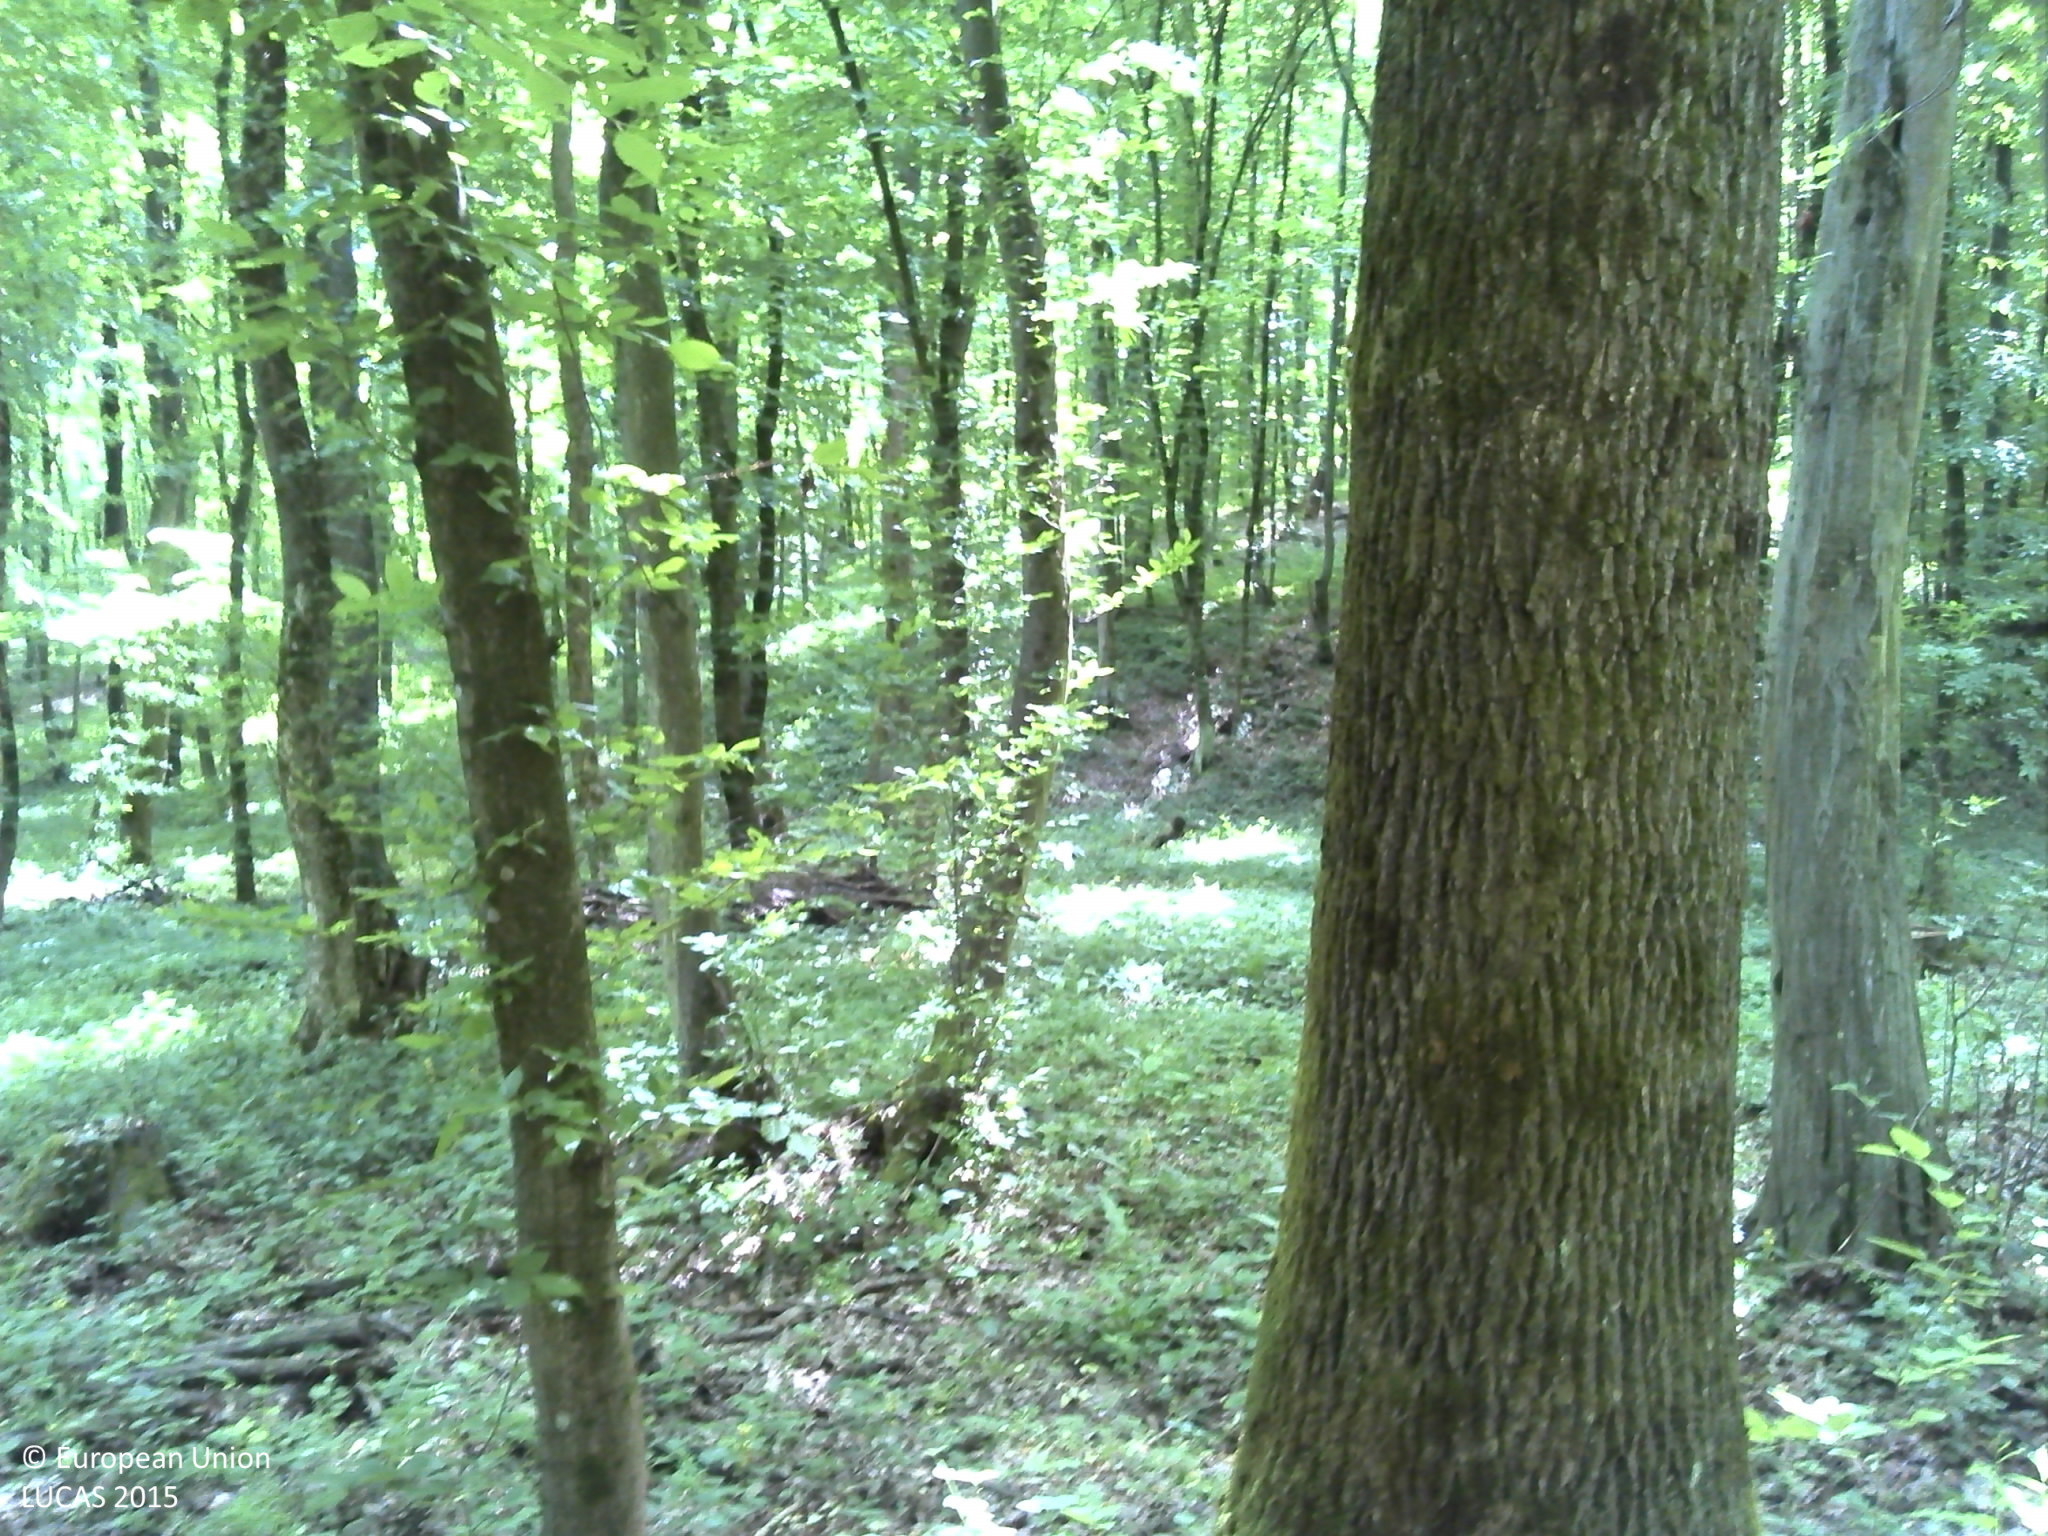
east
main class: Woodland
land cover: Broadleaved woodland
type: acidophilous oak and oak-birch forest
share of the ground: > 75 %
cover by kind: broadleaved forest trees 100 %
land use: Forestry
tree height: > 5 m
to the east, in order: Broadleaved woodland; Spontaneously vegetated surfaces; Broadleaved woodland
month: May
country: HR
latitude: 45.4207
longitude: 18.1962
